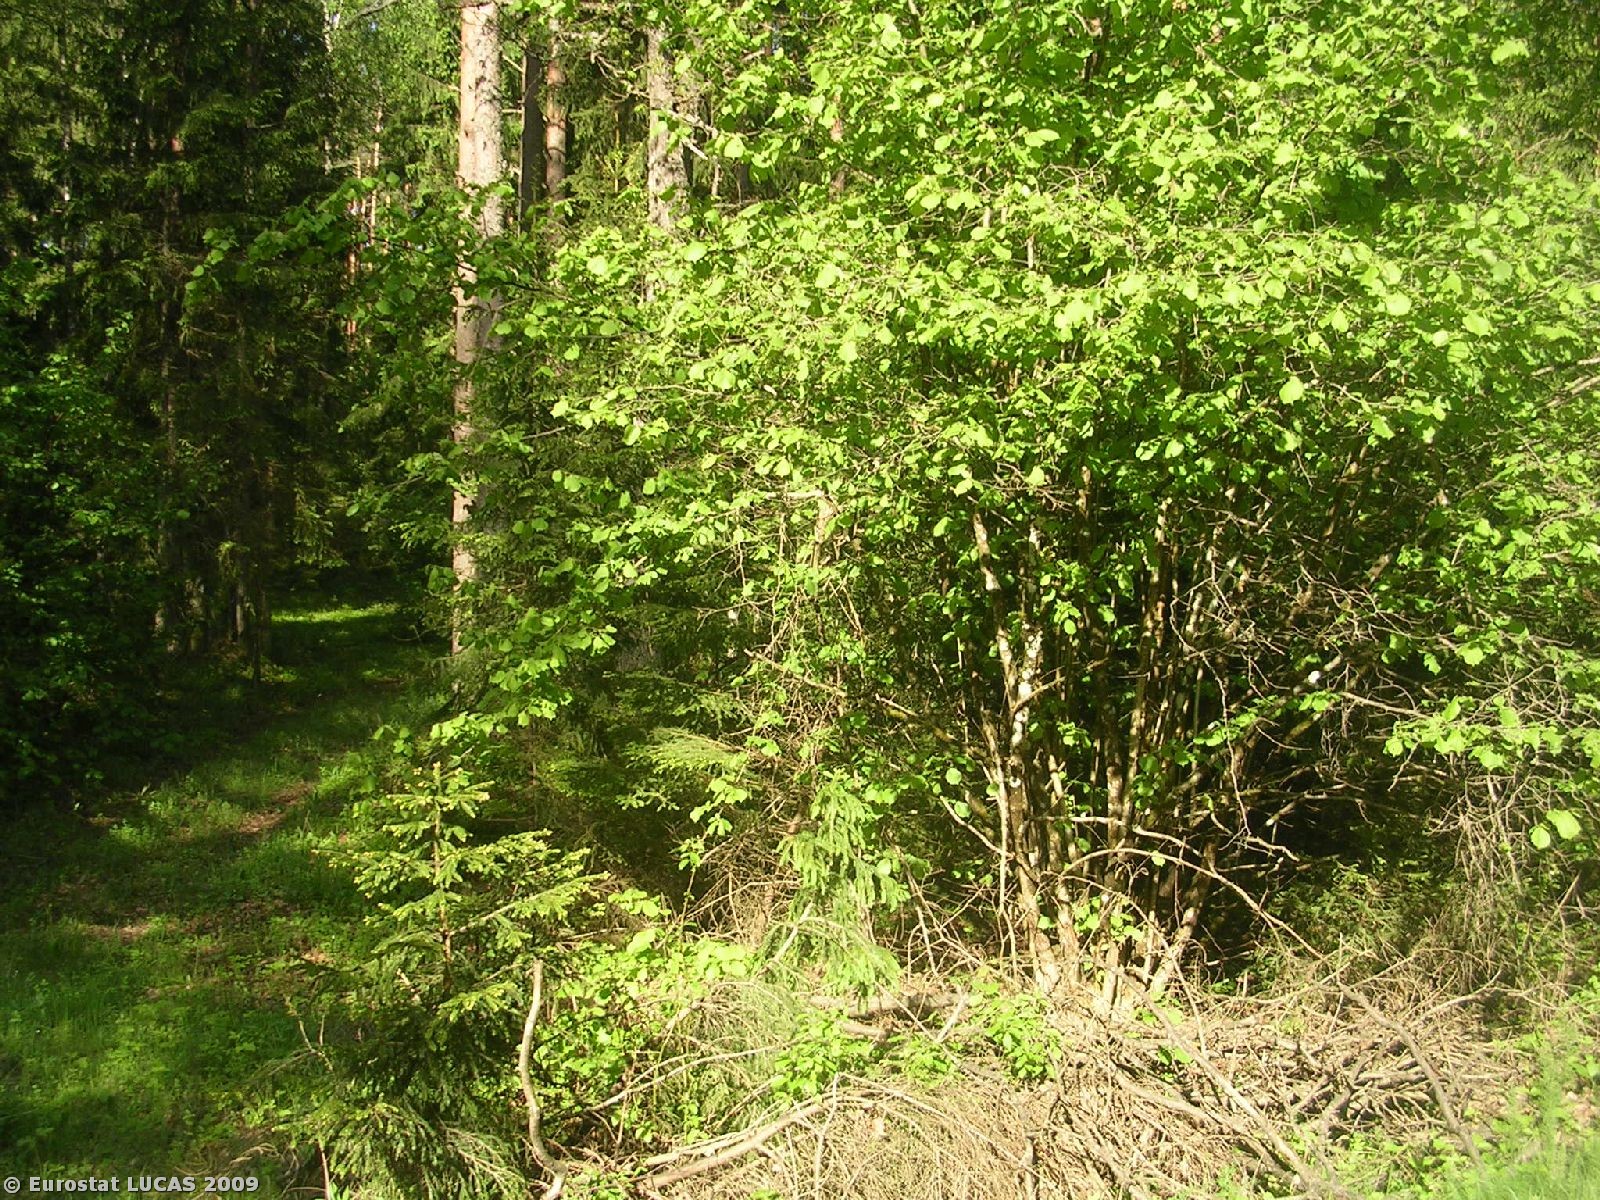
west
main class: Woodland
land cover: Mixed woodland
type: hemiboreal forest and nemoral coniferous forest and mixed broadleaved-coniferous forest
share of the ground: > 75 %
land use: Nature reserves
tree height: > 5 m
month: May
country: PL
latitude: 53.2571
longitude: 23.3775
